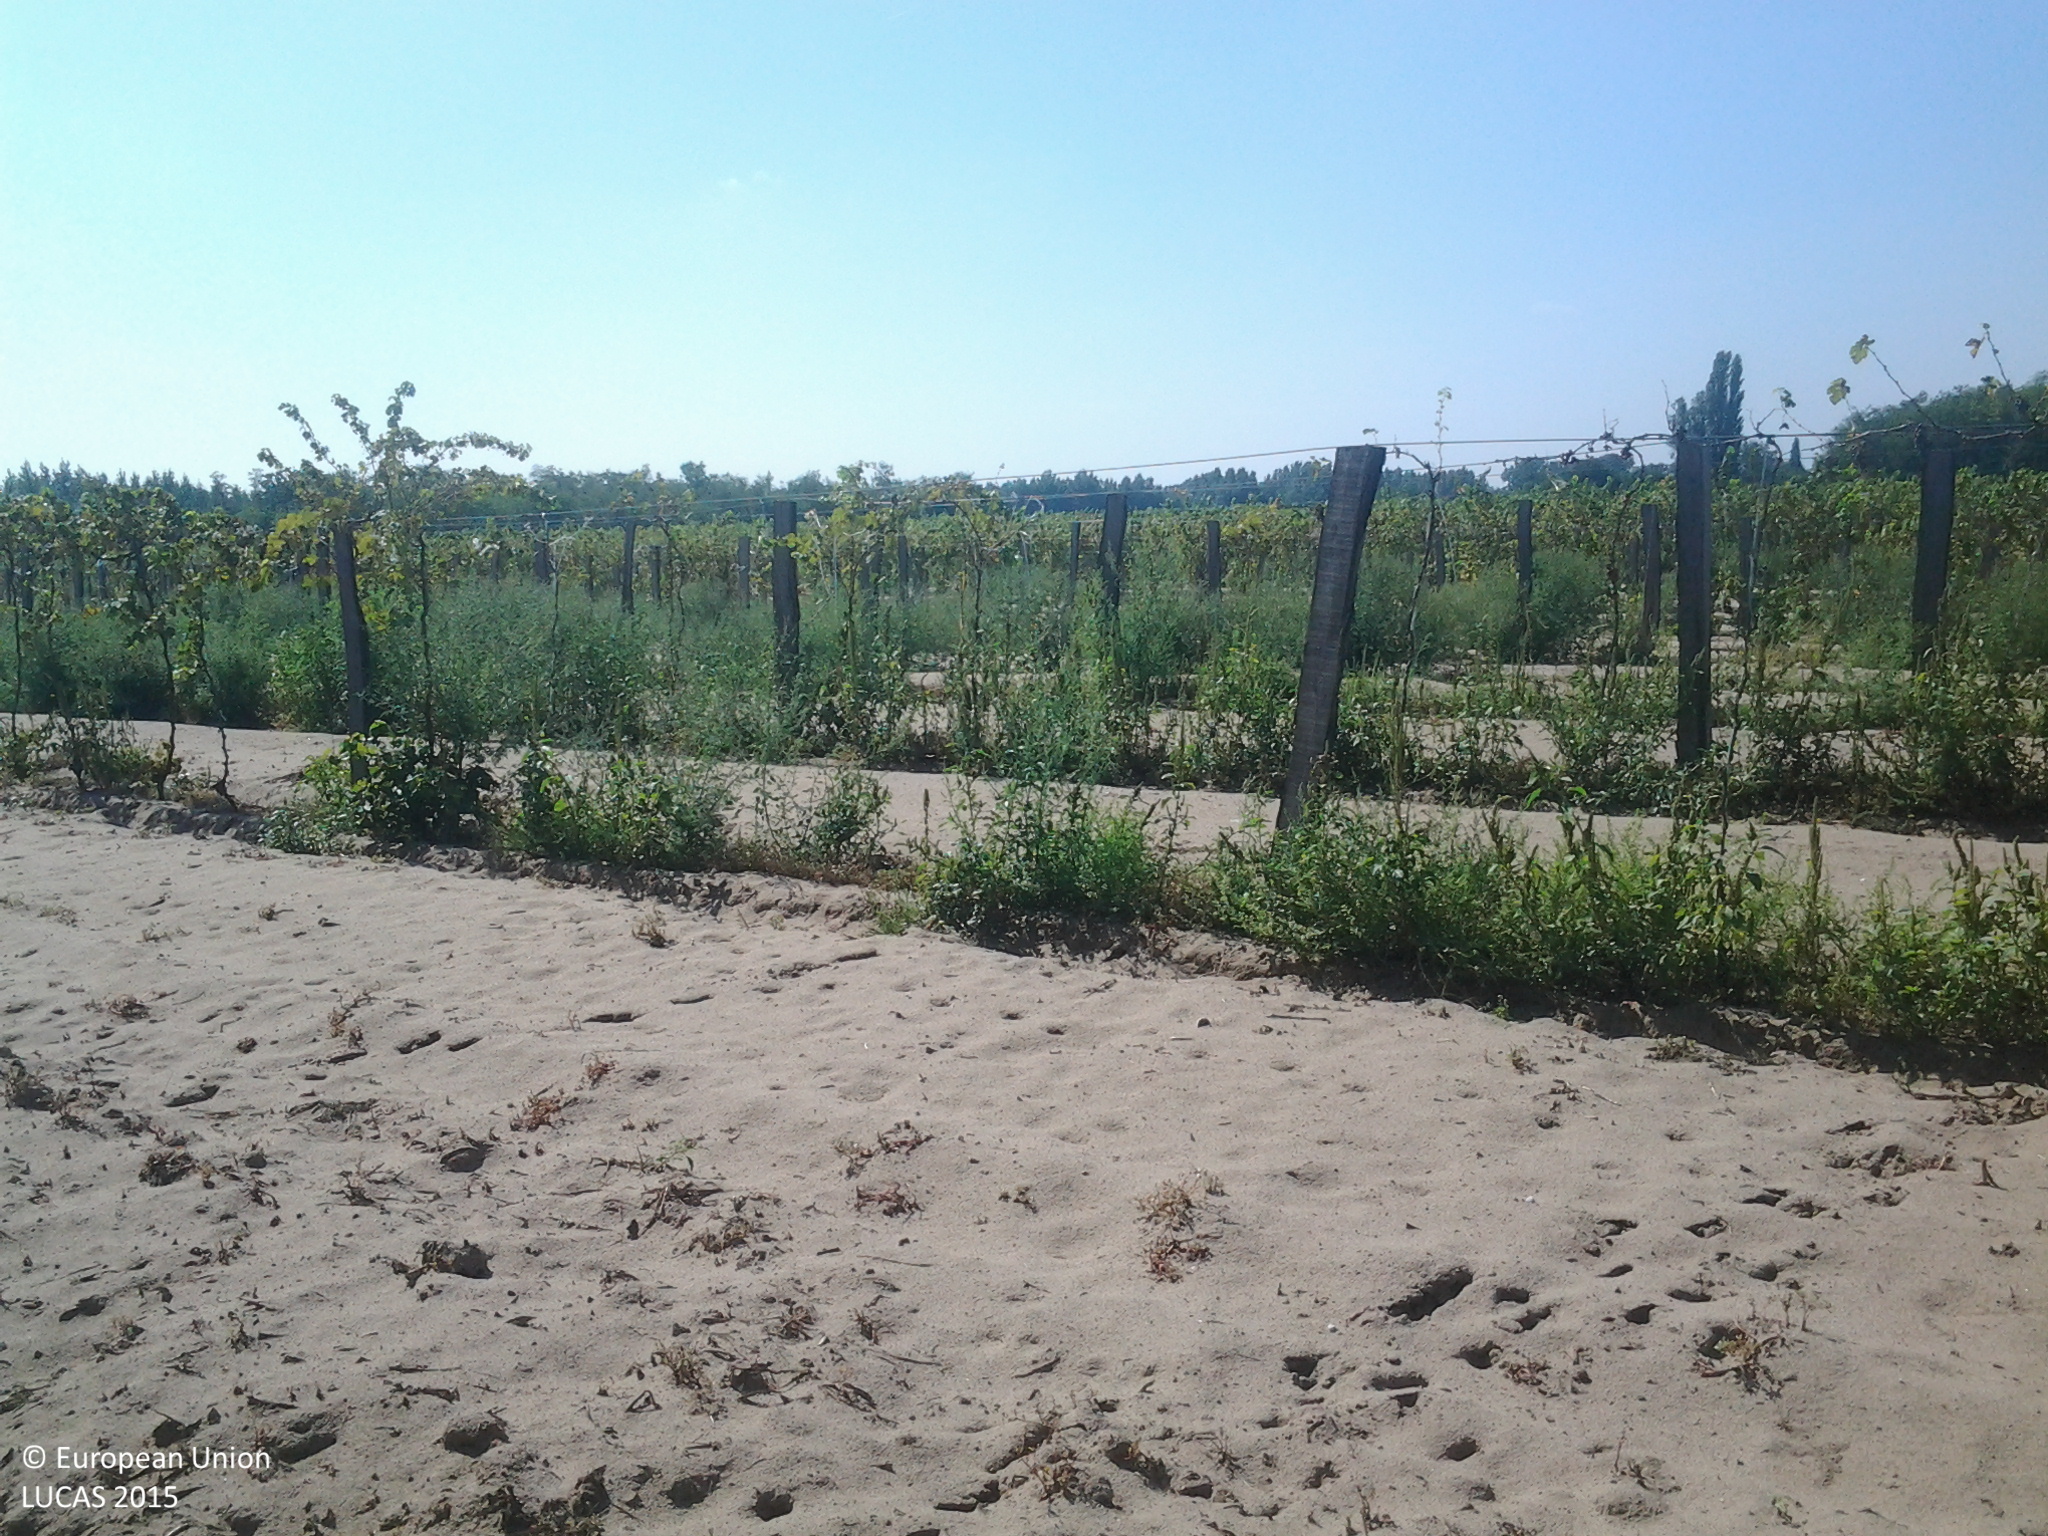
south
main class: Woodland
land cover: Pine dominated coniferous woodland
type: hemiboreal forest and nemoral coniferous forest and mixed broadleaved-coniferous forest
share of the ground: > 75 %
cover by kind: coniferous forest trees 100 %
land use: Forestry
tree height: > 5 m
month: August
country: HU
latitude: 46.7310
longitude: 19.6375
